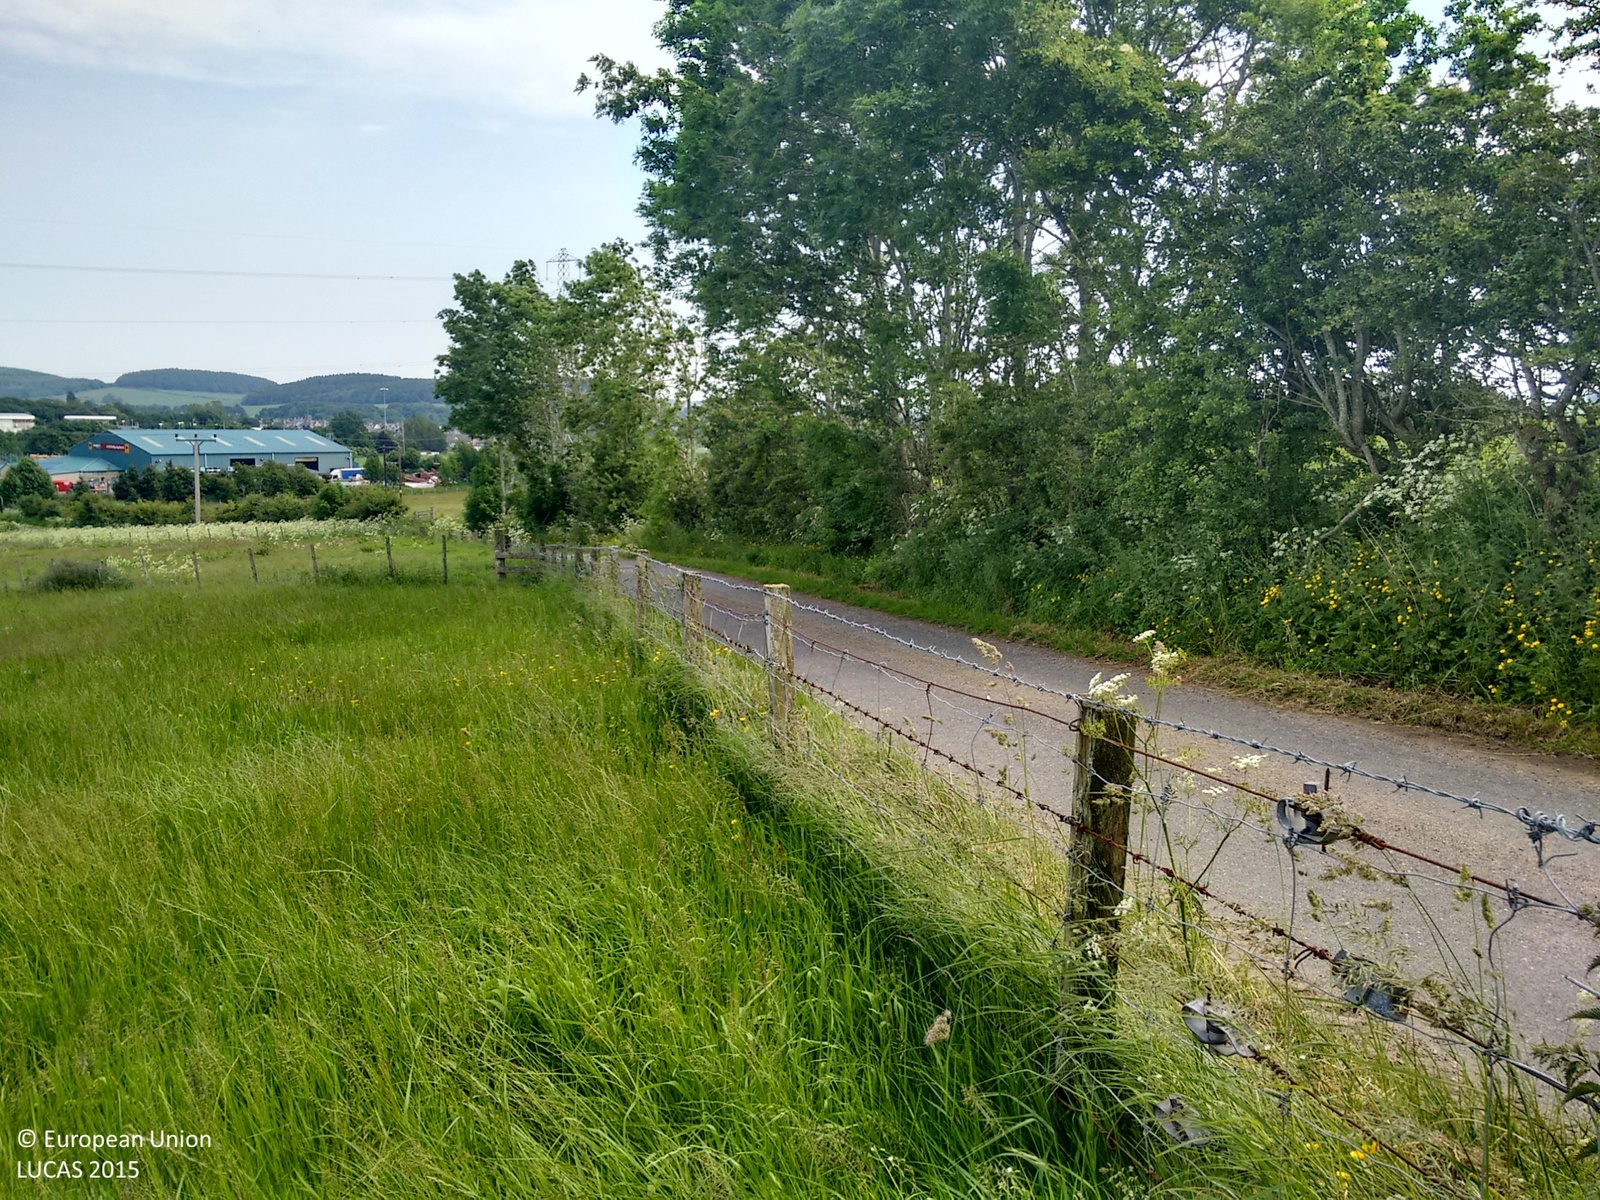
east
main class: Grassland
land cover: Grassland without tree/shrub cover
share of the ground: > 75 %
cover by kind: herbaceous plants 100 %
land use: Agriculture (excluding fallow land and kitchen gardens)
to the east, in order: Grassland without tree/shrub cover; Fences; Grass margins; Paved roads, cycling and walking lanes; Lines of trees; Fences; Grassland without tree/shrub cover; Fences; Grass margins; Fences; Tracks; Managed hedges; Fences; Grassland without tree/shrub cover; Artificial constructions in urban areas; Barley
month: July
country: GB
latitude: 57.4397
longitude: -2.8028
